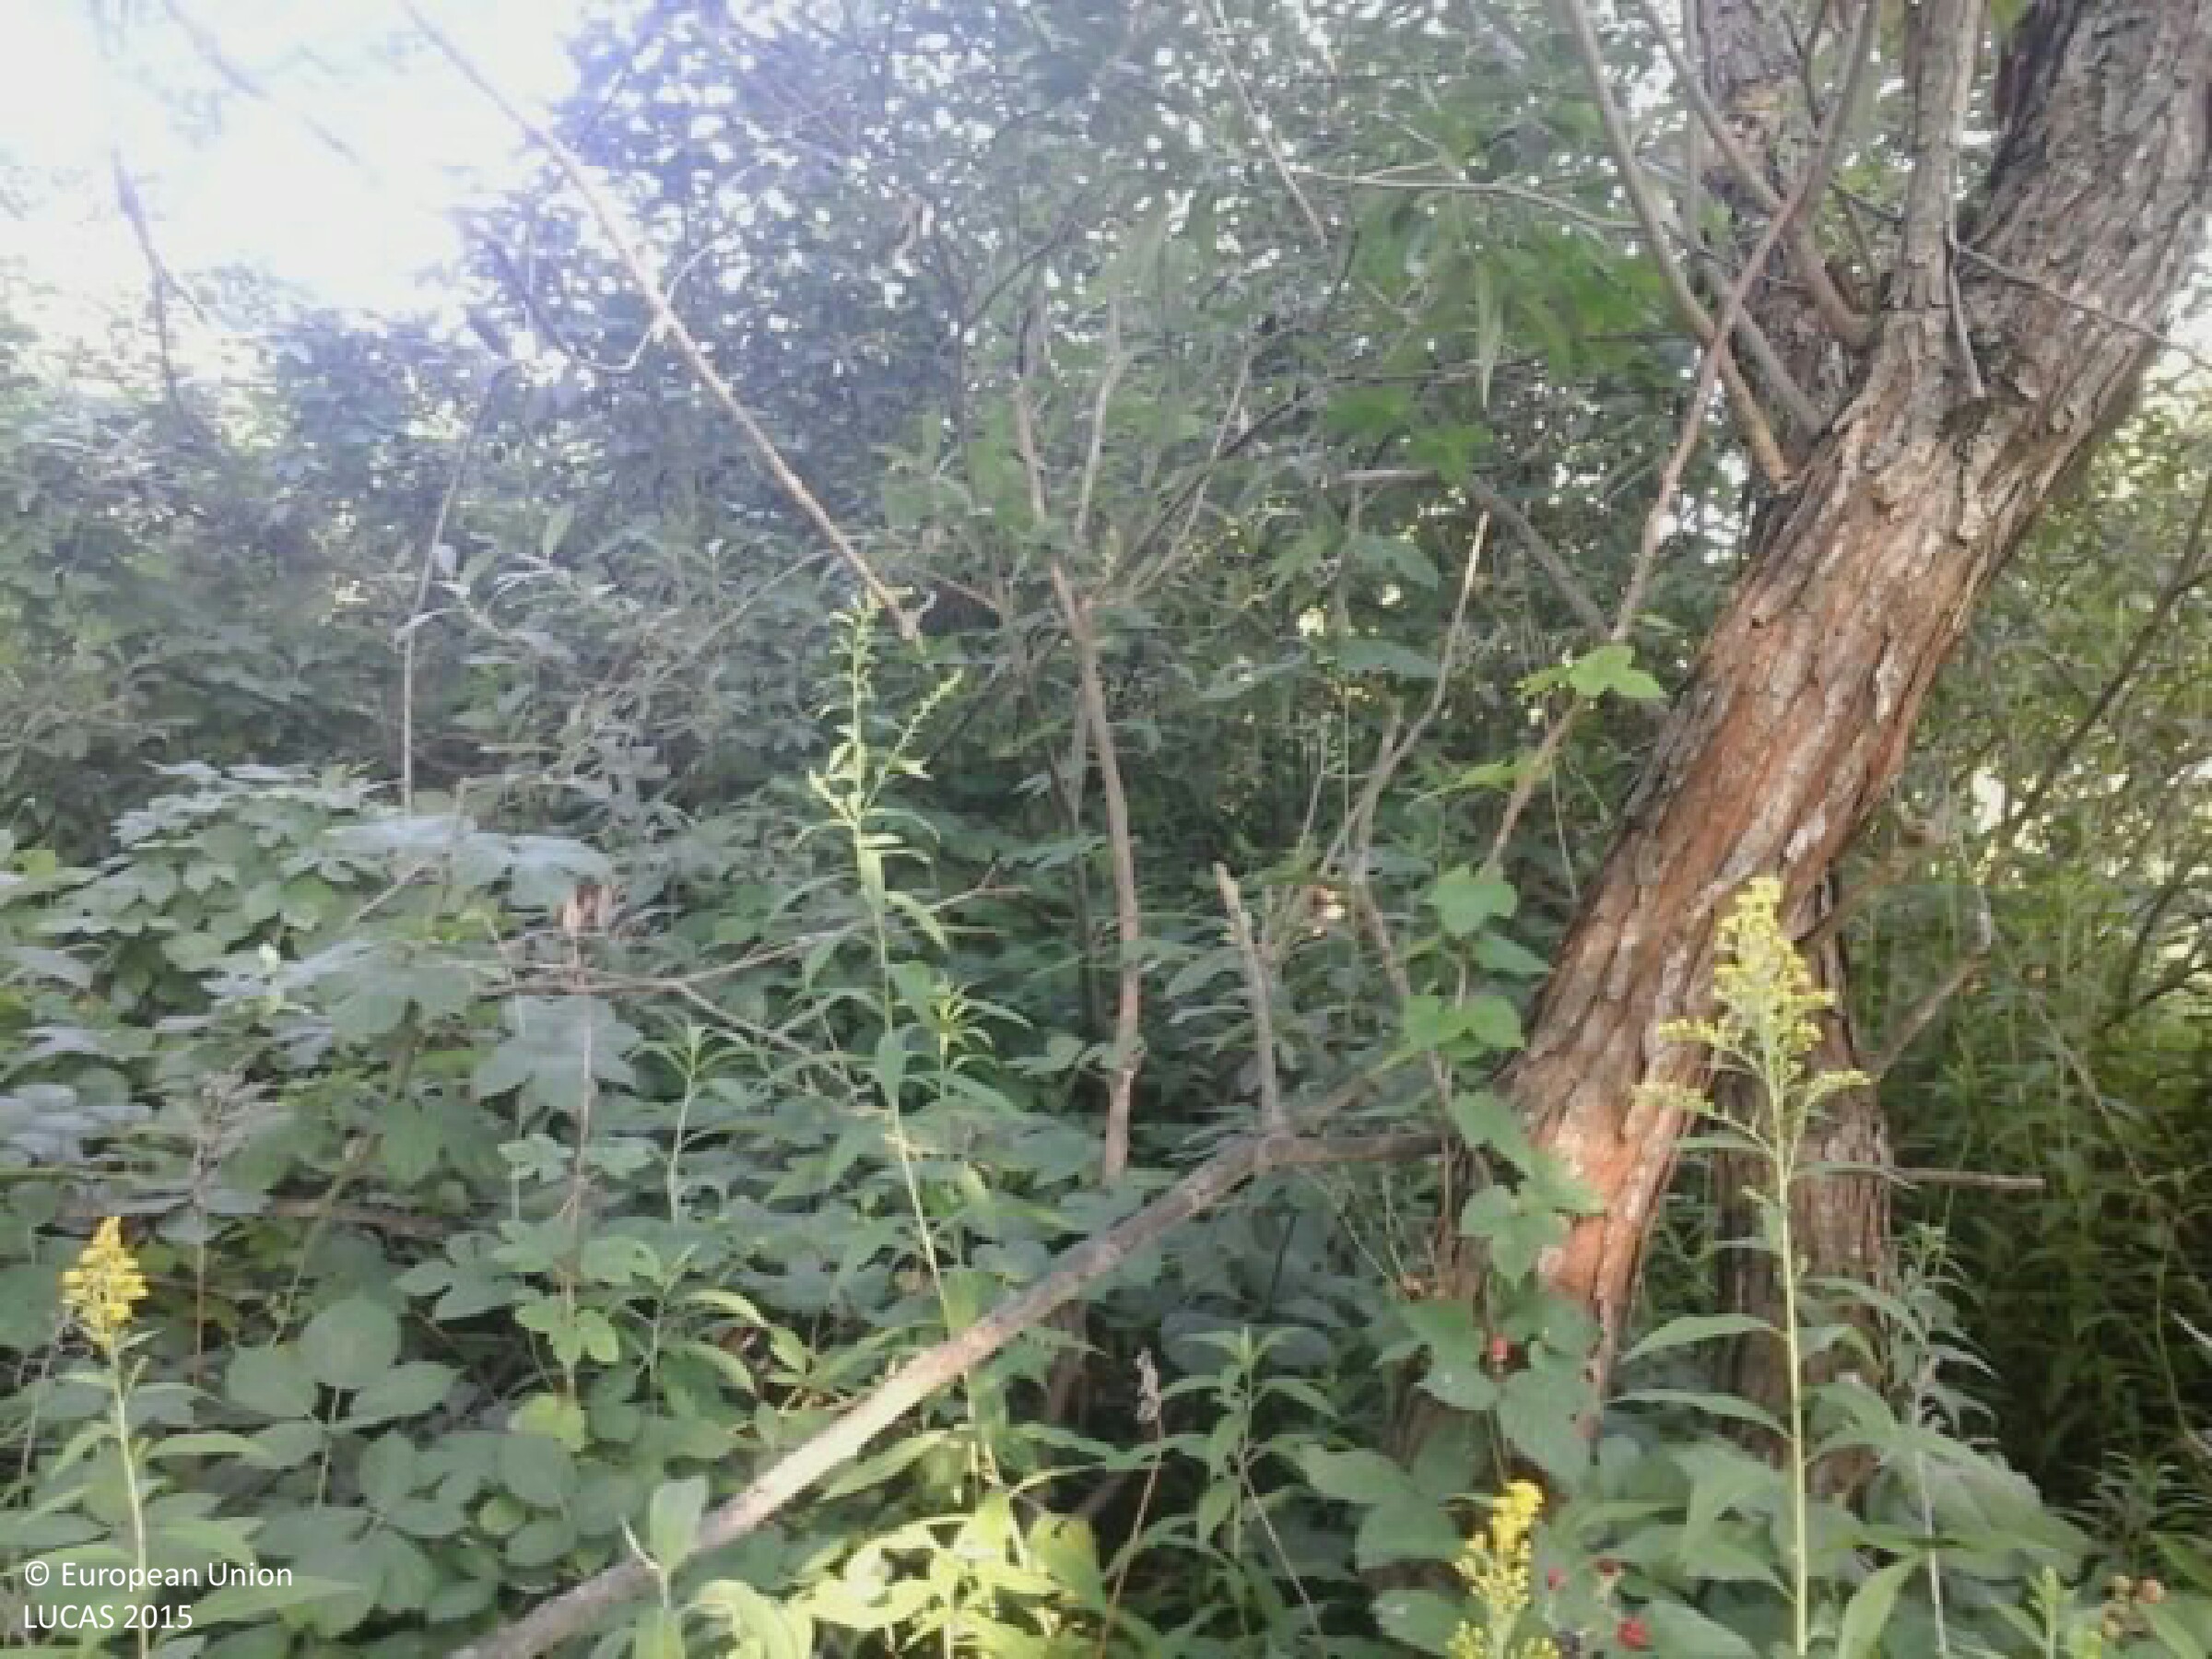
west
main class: Woodland
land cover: Broadleaved woodland
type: mesophytic deciduous forest
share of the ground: > 75 %
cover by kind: broadleaved forest trees 75 %, shrubs 15 %, herbaceous plants 10 %
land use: Semi-natural and natural areas not in use
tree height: > 5 m
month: August
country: HU
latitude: 46.7133
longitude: 17.3436
